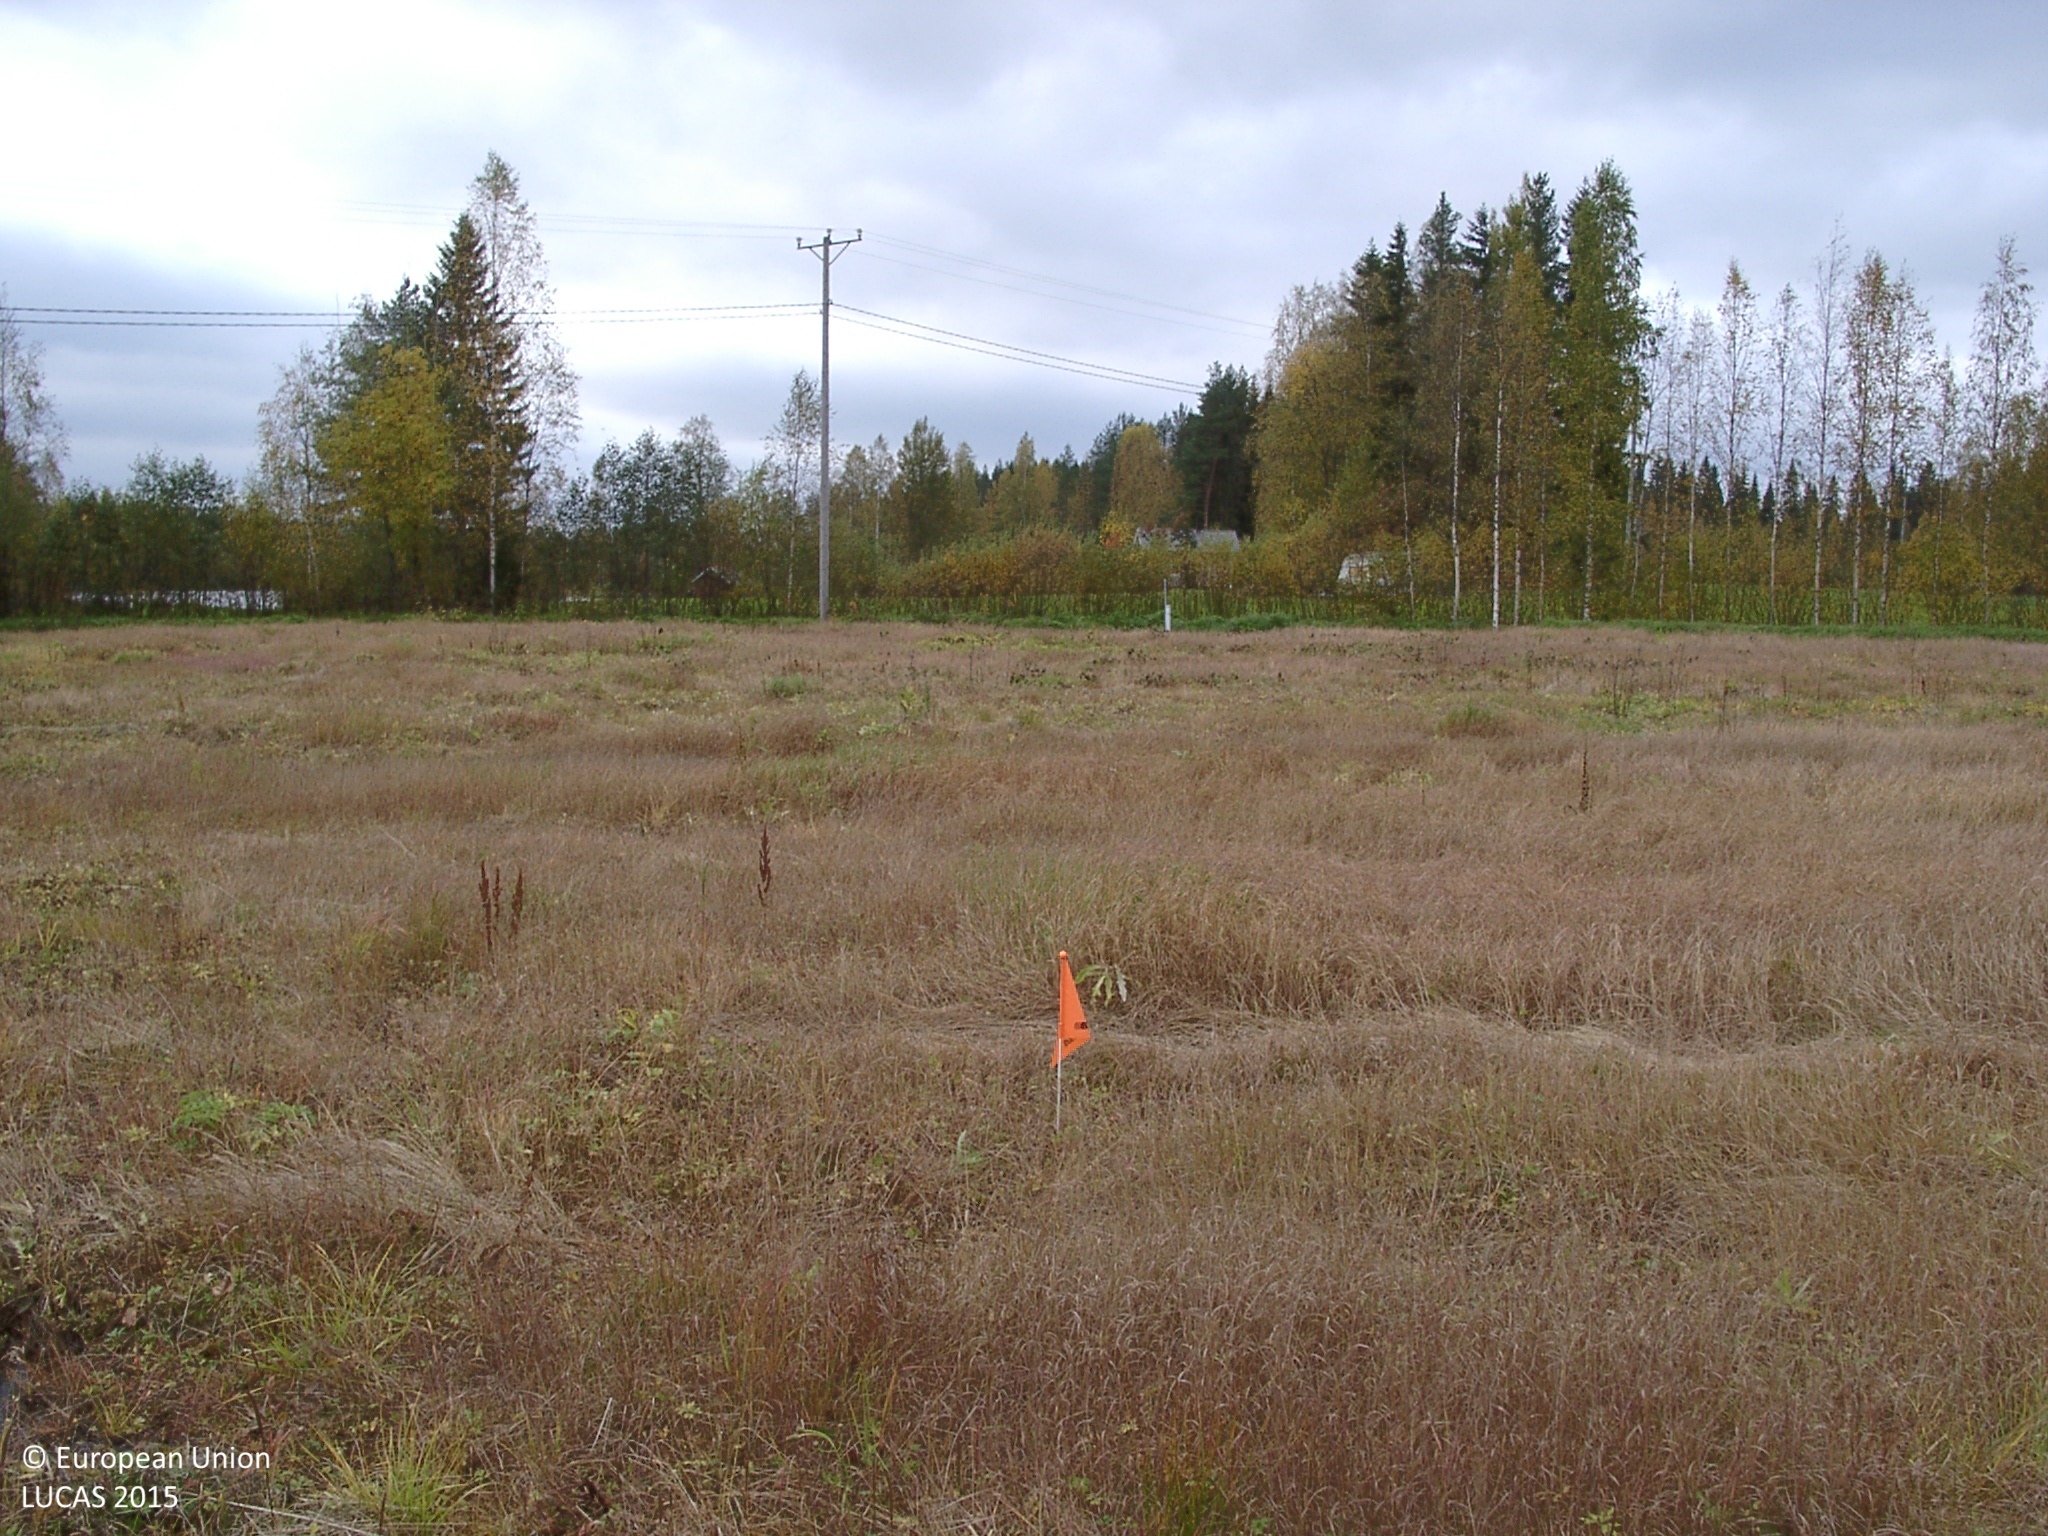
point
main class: Grassland
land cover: Spontaneously vegetated surfaces
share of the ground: > 75 %
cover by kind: herbaceous plants 100 %
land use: Fallow land
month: September
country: FI
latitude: 62.6000
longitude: 25.2788
